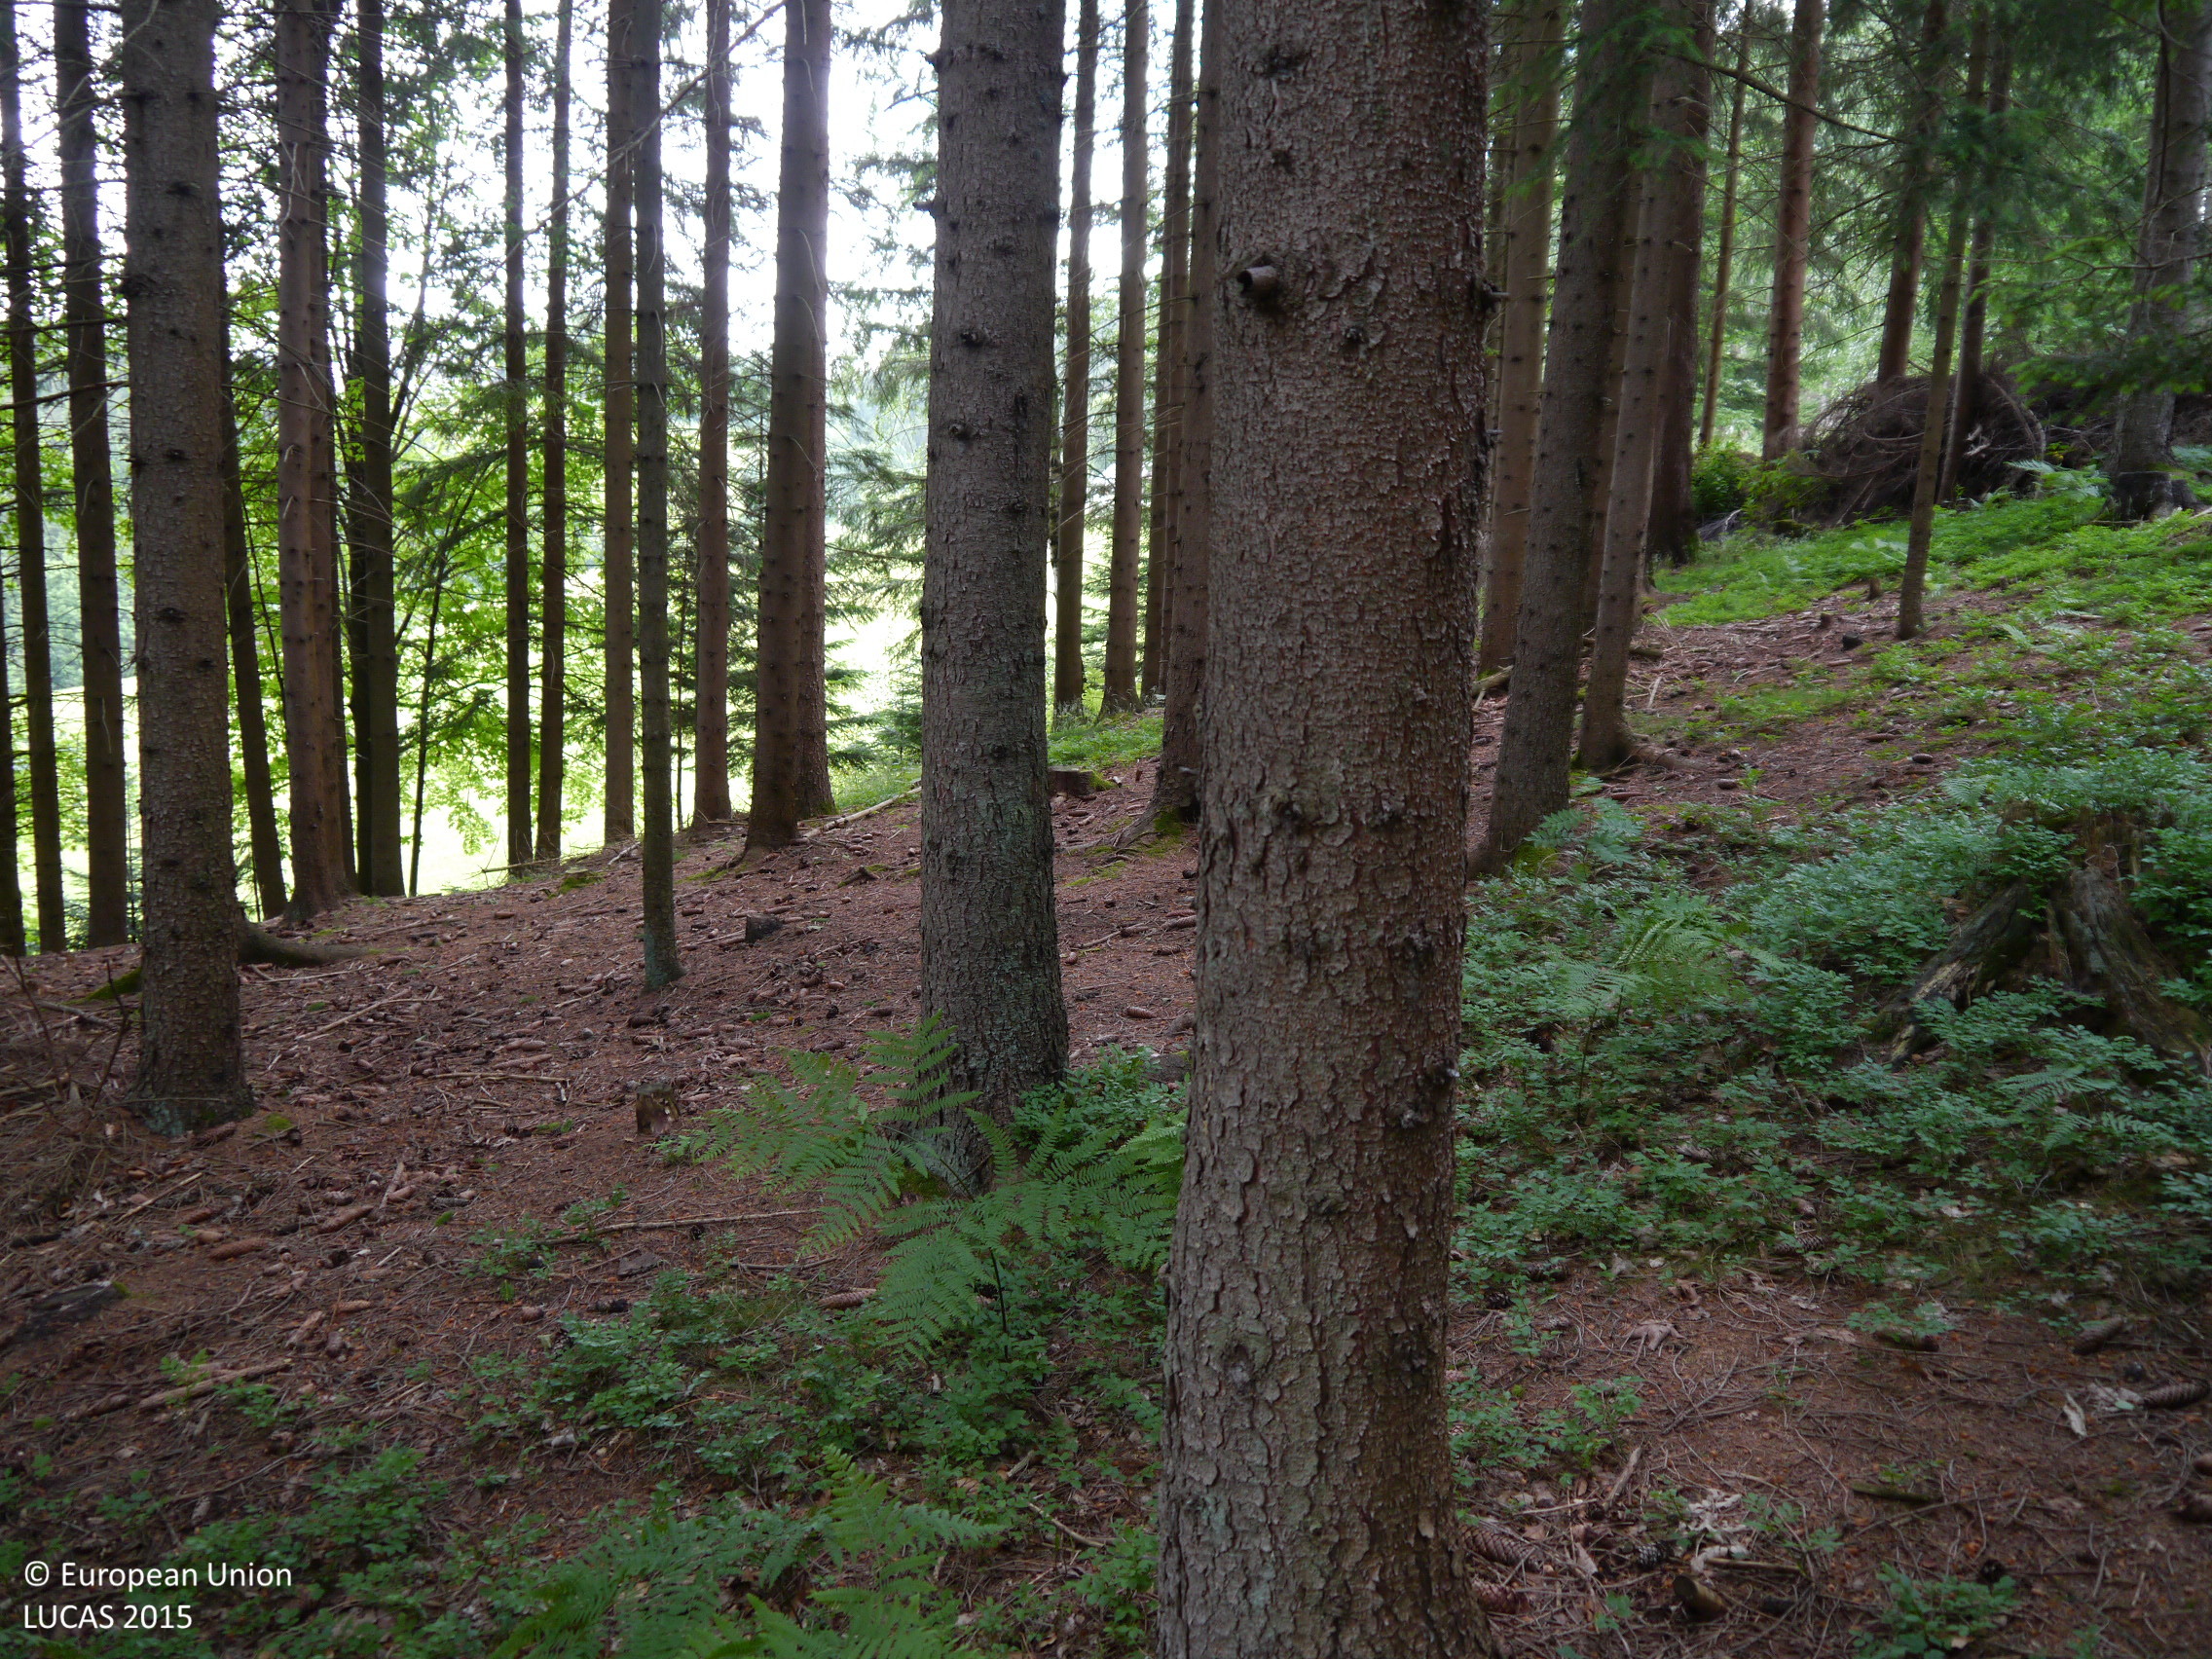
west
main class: Woodland
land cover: Spruce dominated coniferous woodland
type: alpine coniferous forest
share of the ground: > 75 %
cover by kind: coniferous forest trees 100 %
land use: Forestry
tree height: > 5 m
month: June
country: AT
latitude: 46.6814
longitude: 15.0841
